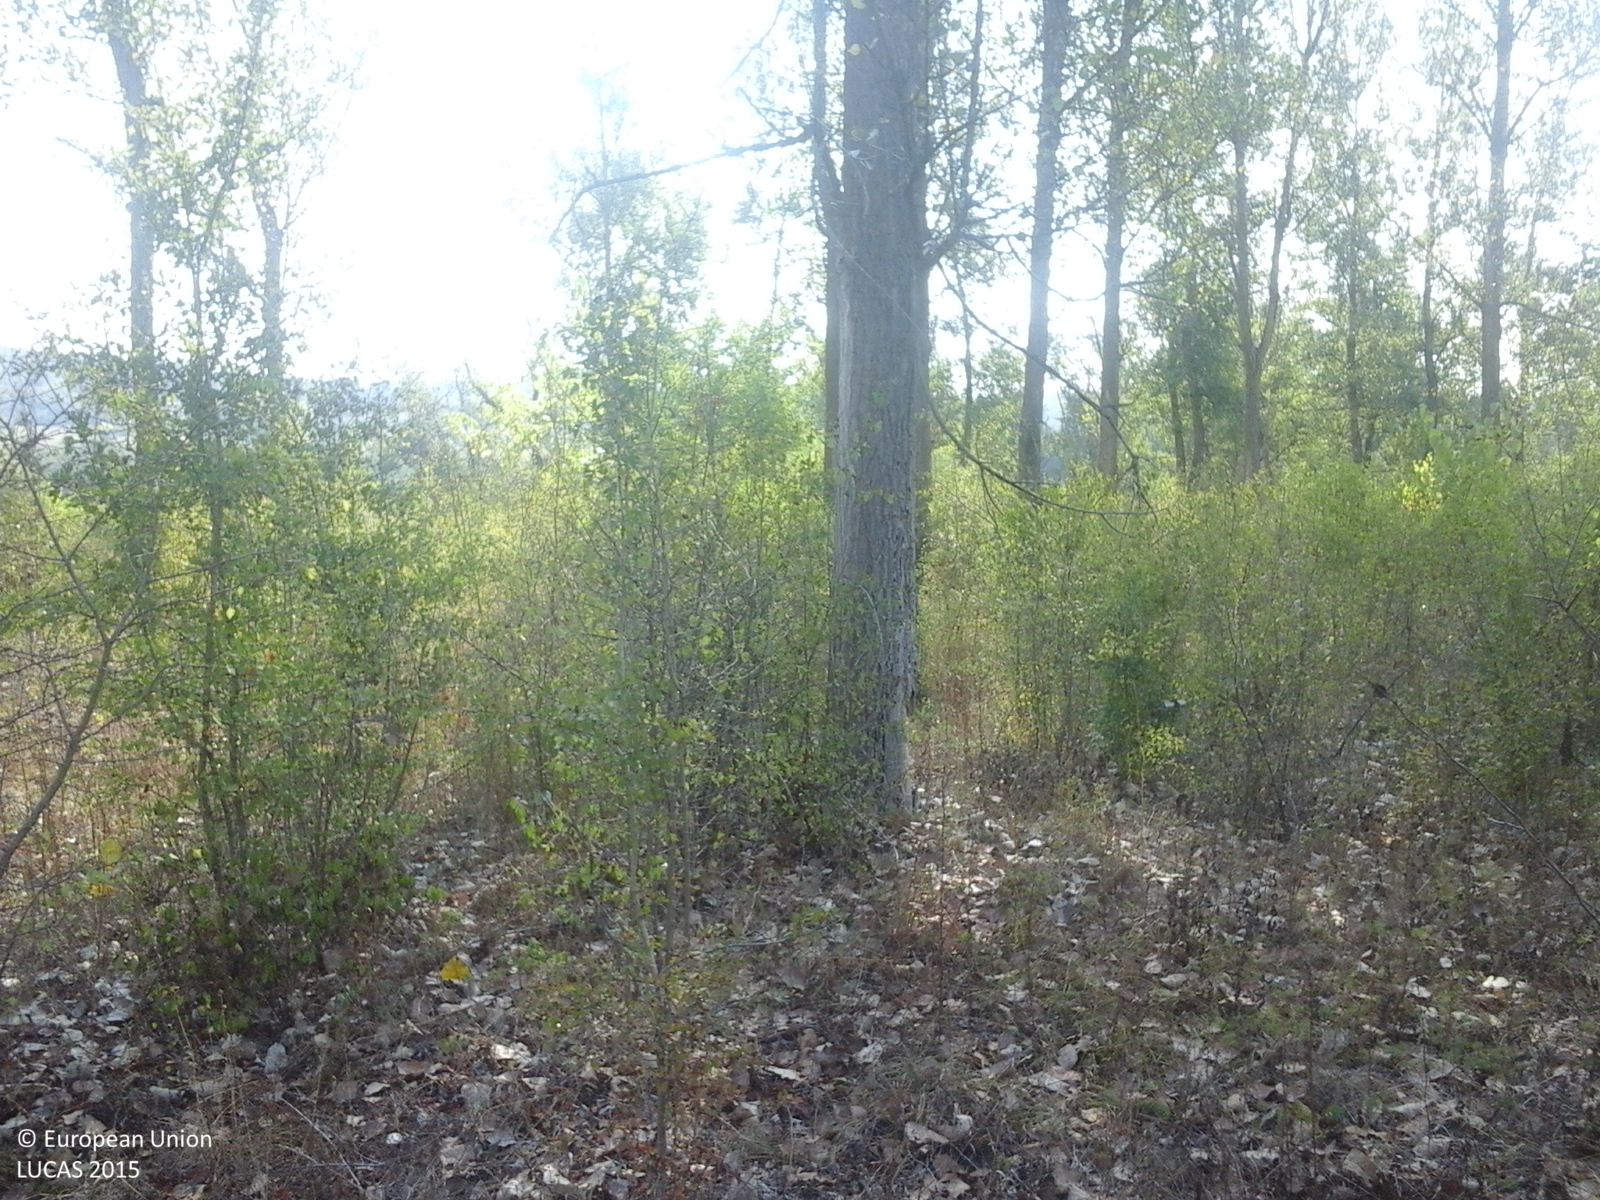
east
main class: Grassland
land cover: Grassland with sparse tree/shrub cover
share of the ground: > 75 %
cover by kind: herbaceous plants 85 %, shrubs 10 %, broadleaved forest trees 5 %
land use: Fallow land
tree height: < 5 m
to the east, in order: Grassland with sparse tree/shrub cover; Broadleaved woodland; Tracks; Broadleaved woodland; Grassland with sparse tree/shrub cover; Spontaneously vegetated surfaces
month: August
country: RO
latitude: 44.7946
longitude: 23.5184
